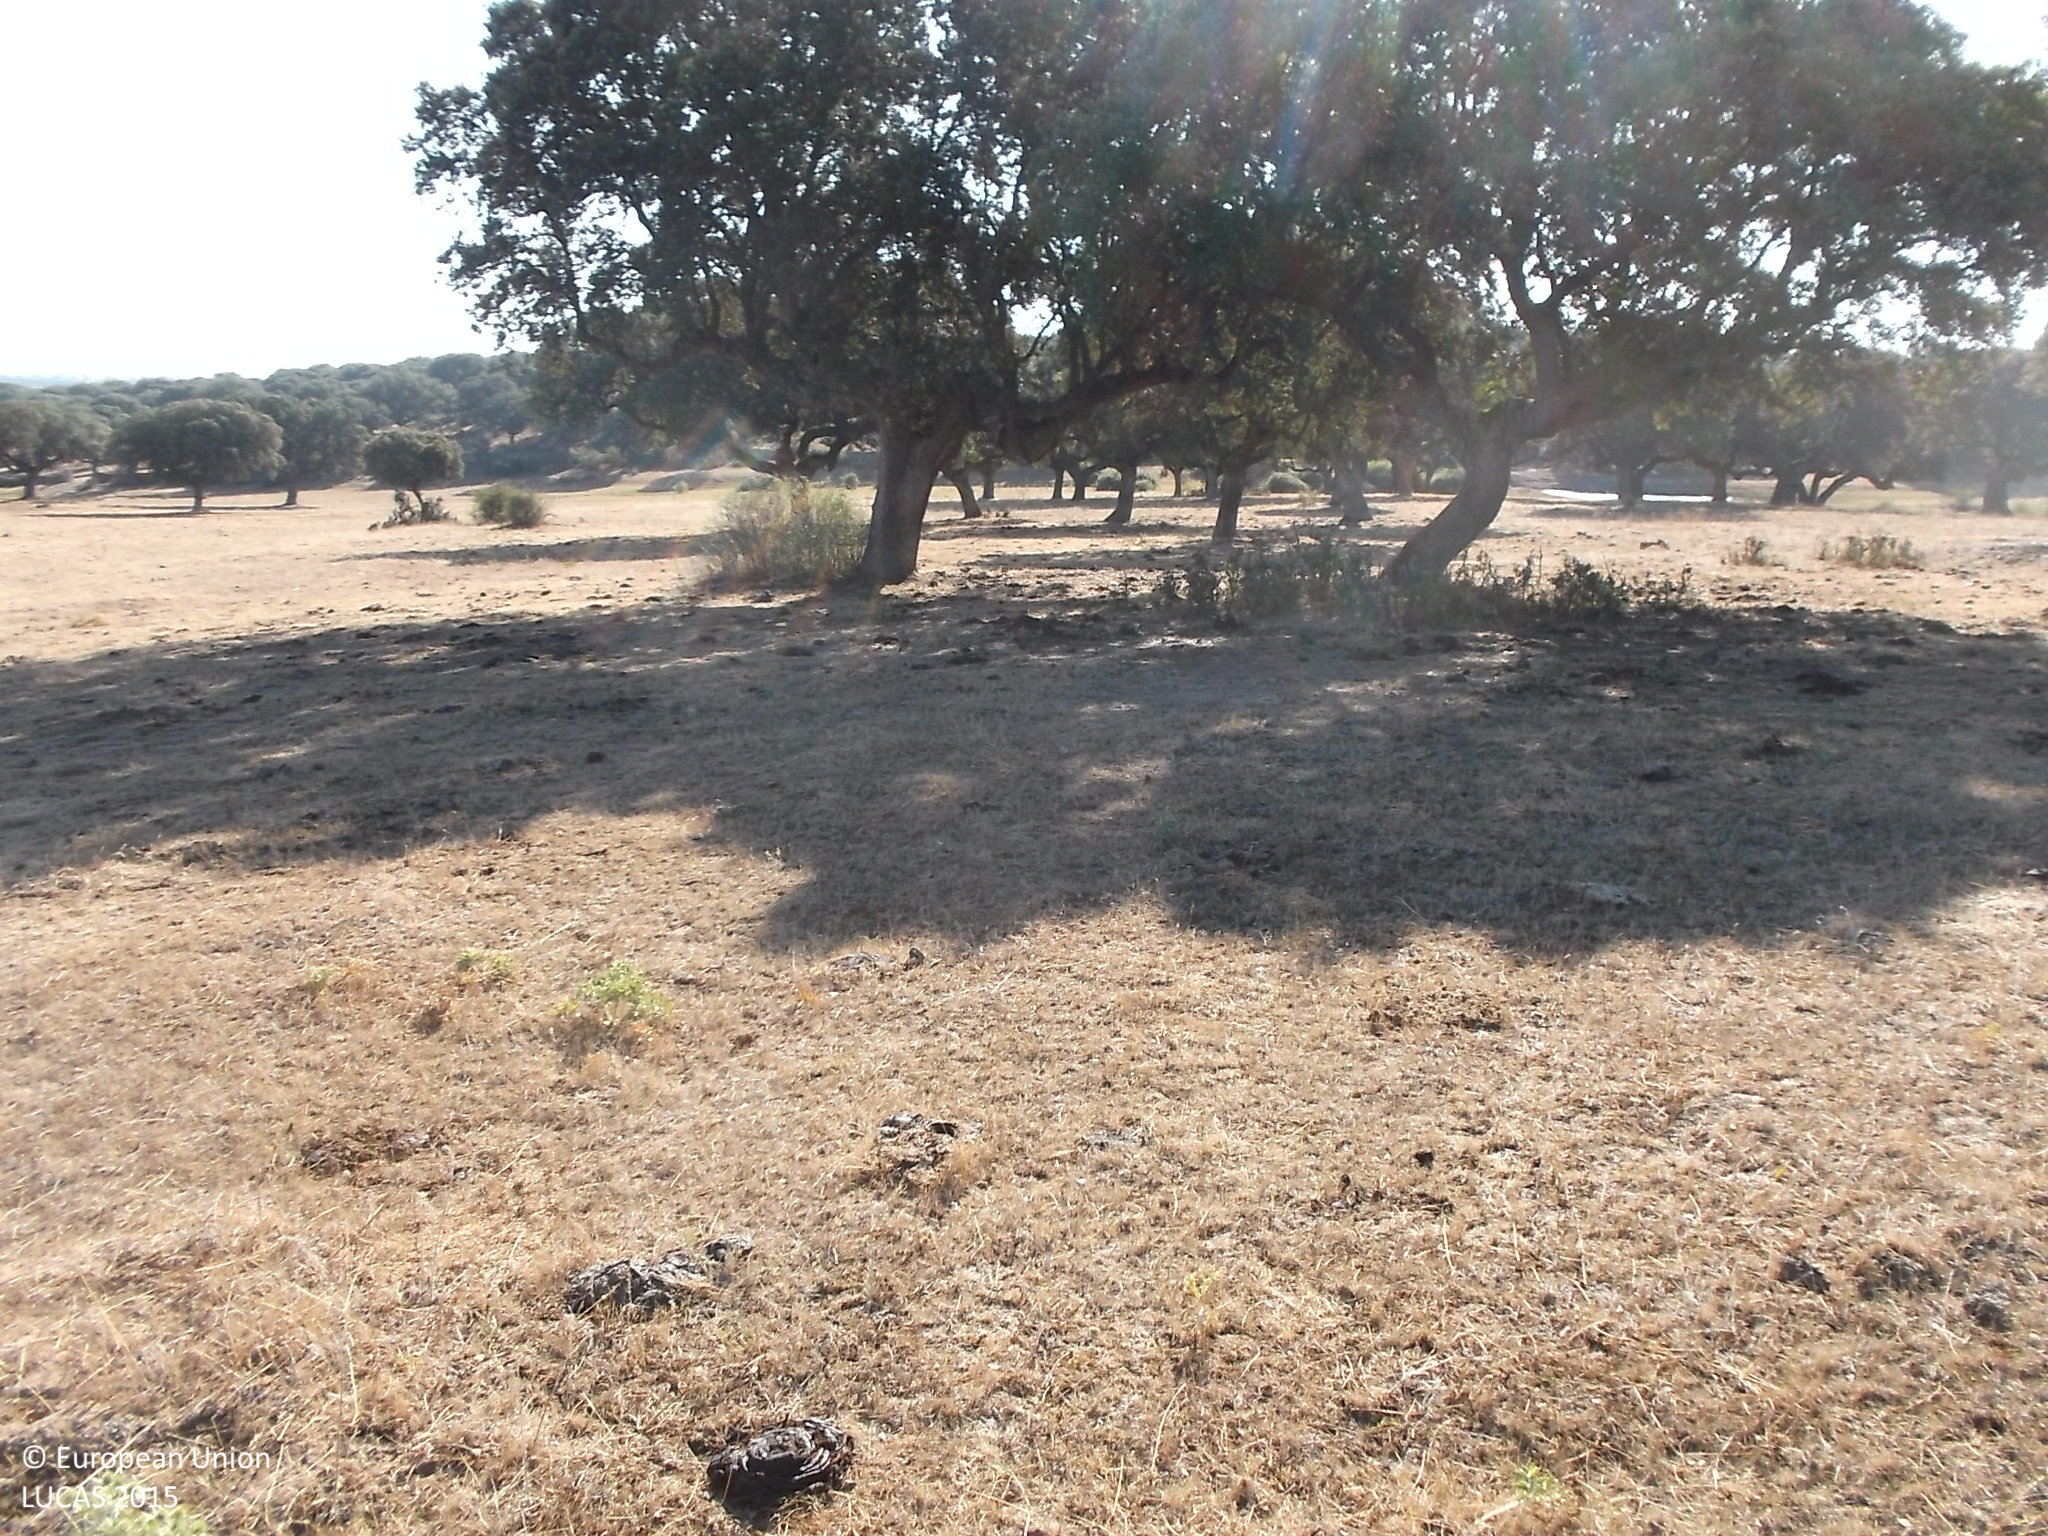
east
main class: Grassland
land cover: Grassland with sparse tree/shrub cover
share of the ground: > 75 %
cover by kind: herbaceous plants 90 %, broadleaved forest trees 5 %, shrubs 5 %
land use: Agriculture (excluding fallow land and kitchen gardens)
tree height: < 5 m
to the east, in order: Grassland with sparse tree/shrub cover; Grassland without tree/shrub cover; Broadleaved woodland; Grassland without tree/shrub cover; Inland fresh water bodies; Broadleaved woodland; Dry stone walls; Broadleaved woodland
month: July
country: ES
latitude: 41.1037
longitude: -5.9574
